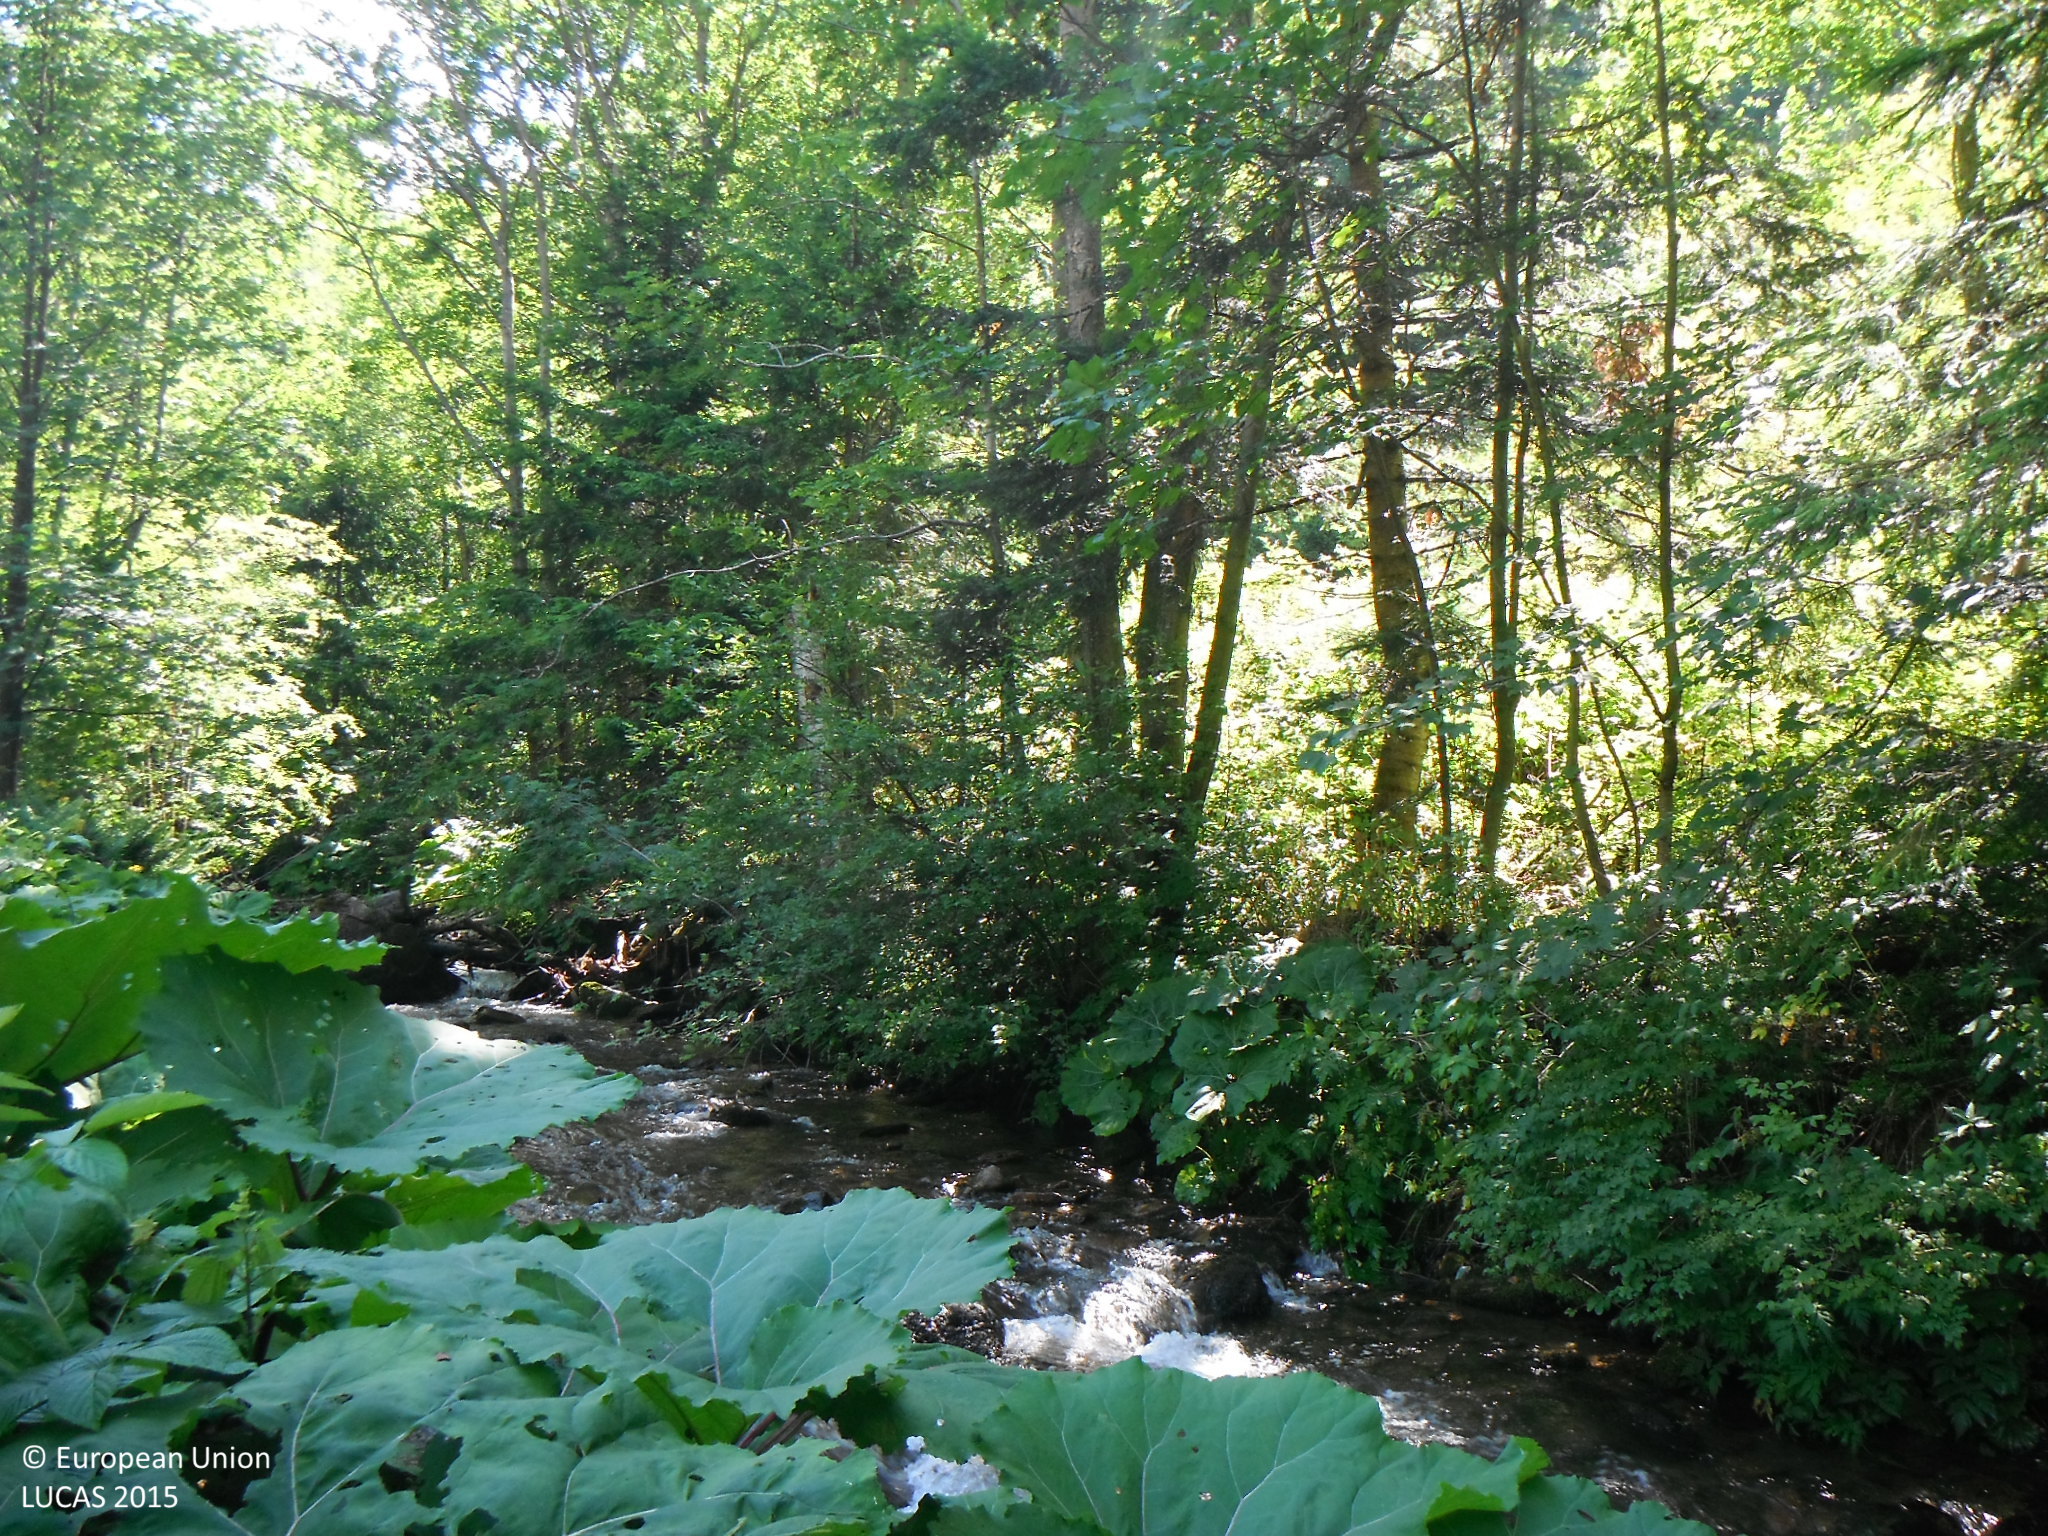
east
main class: Woodland
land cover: Spruce dominated mixed woodland
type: mountainous beech forest
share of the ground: > 75 %
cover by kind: broadleaved forest trees 50 %, coniferous forest trees 25 %, shrubs 15 %, herbaceous plants 10 %
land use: Forestry
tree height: > 5 m
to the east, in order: Spruce dominated mixed woodland; Broadleaved woodland; Spontaneously vegetated surfaces
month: July
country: SK
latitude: 48.8848
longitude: 19.6689
